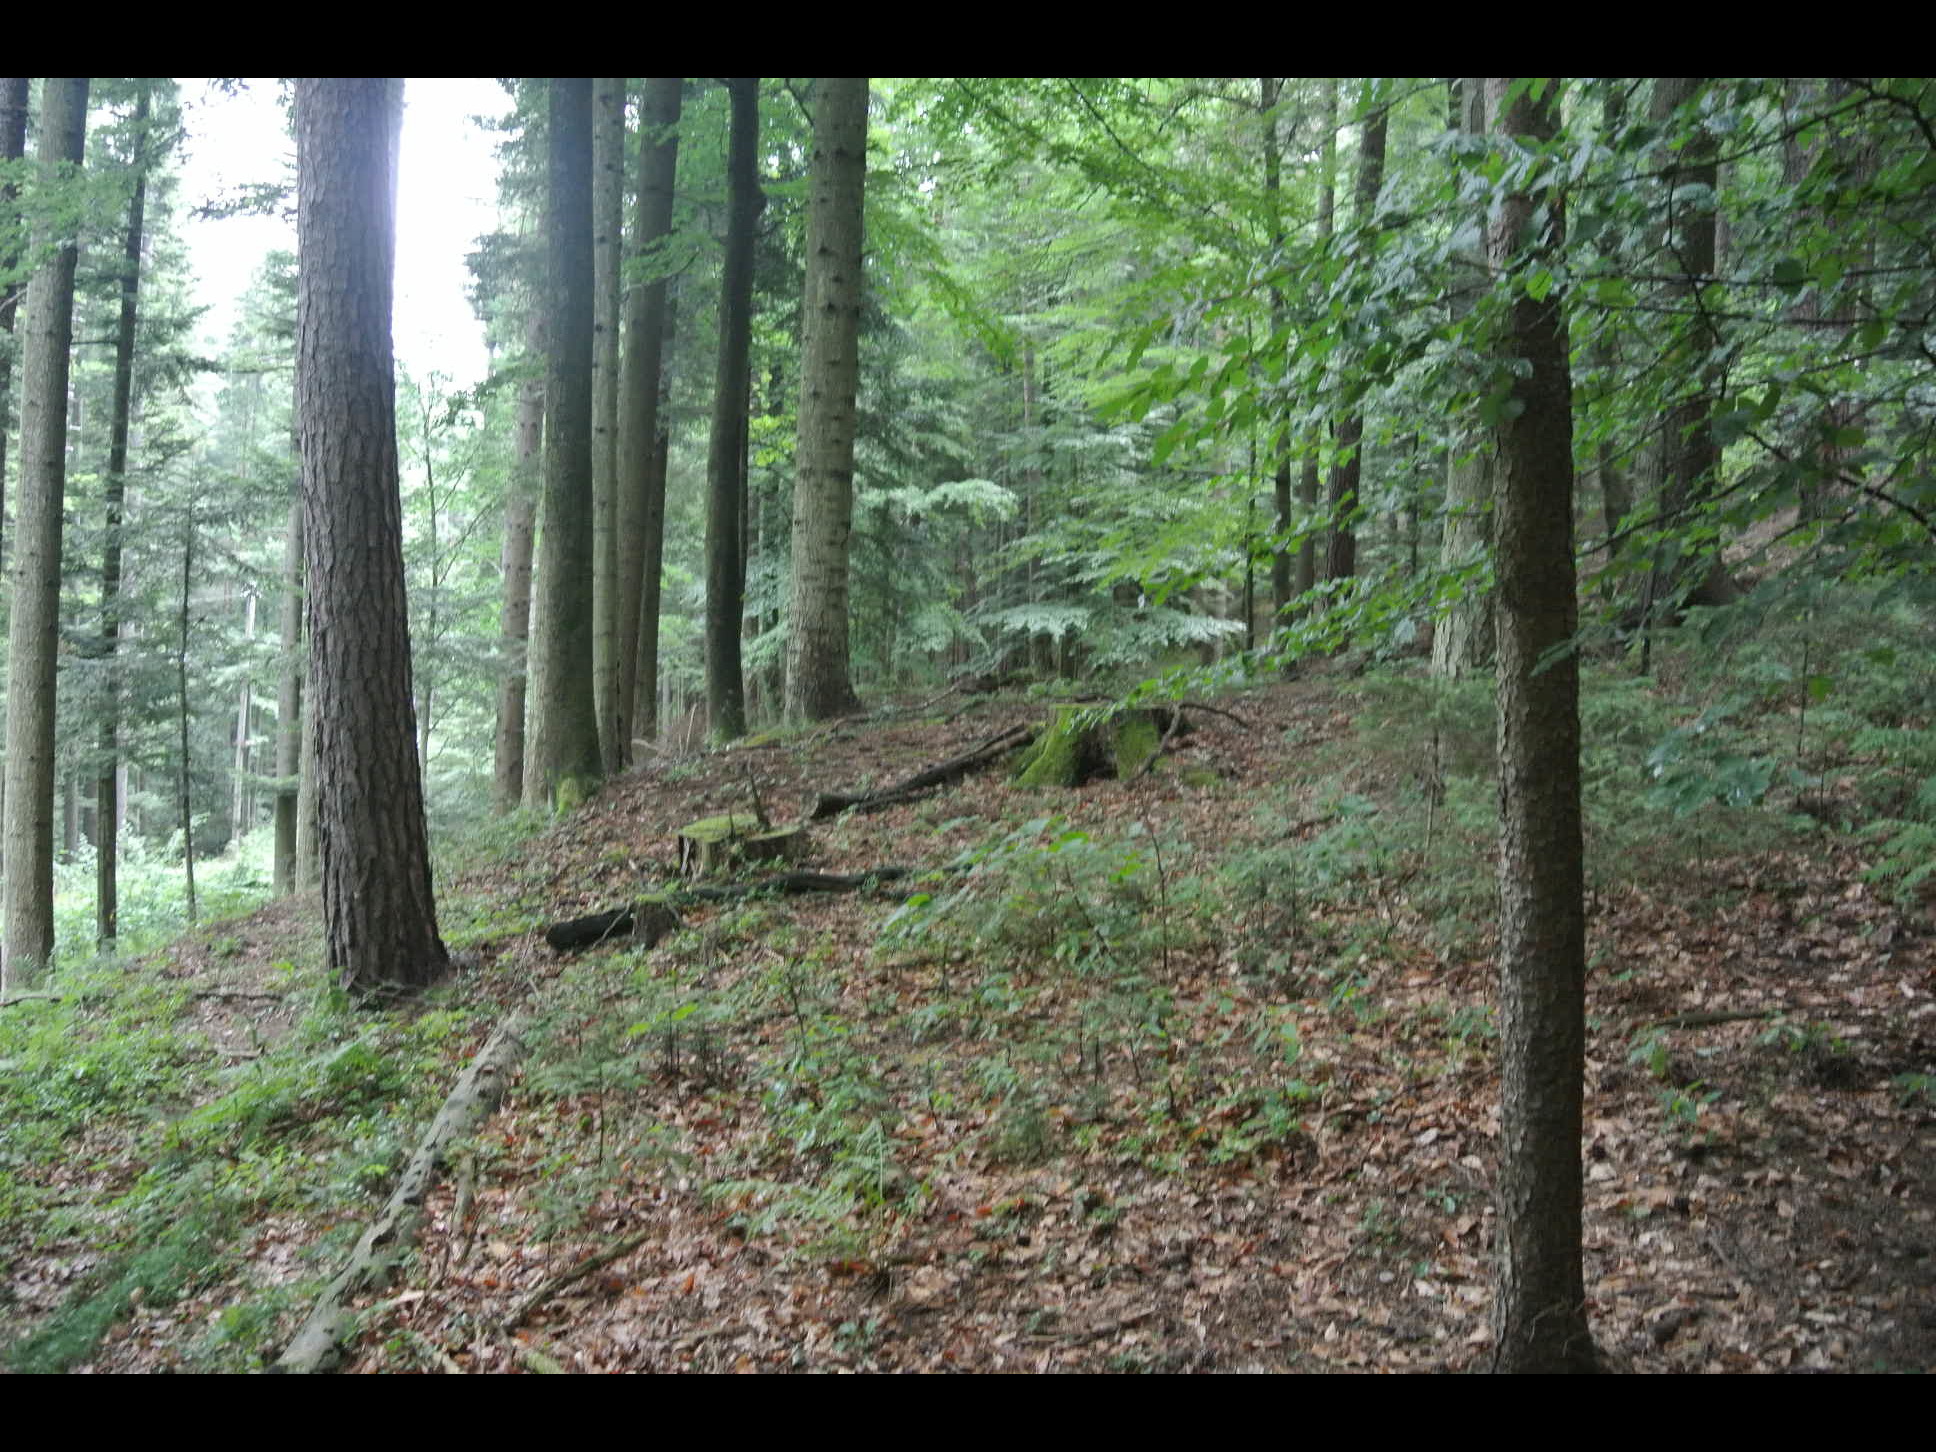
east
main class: Woodland
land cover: Spruce dominated coniferous woodland
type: alpine coniferous forest
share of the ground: > 75 %
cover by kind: coniferous forest trees 75 %, broadleaved forest trees 20 %, herbaceous plants 5 %
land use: Forestry
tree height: > 5 m
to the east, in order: Spruce dominated coniferous woodland; Tracks; Spruce dominated mixed woodland; Tracks; Spruce dominated mixed woodland; Tracks; Pine dominated mixed woodland; Other coniferous woodland; Spruce dominated coniferous woodland; Tracks
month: July
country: AT
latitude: 47.6209
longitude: 16.1101
